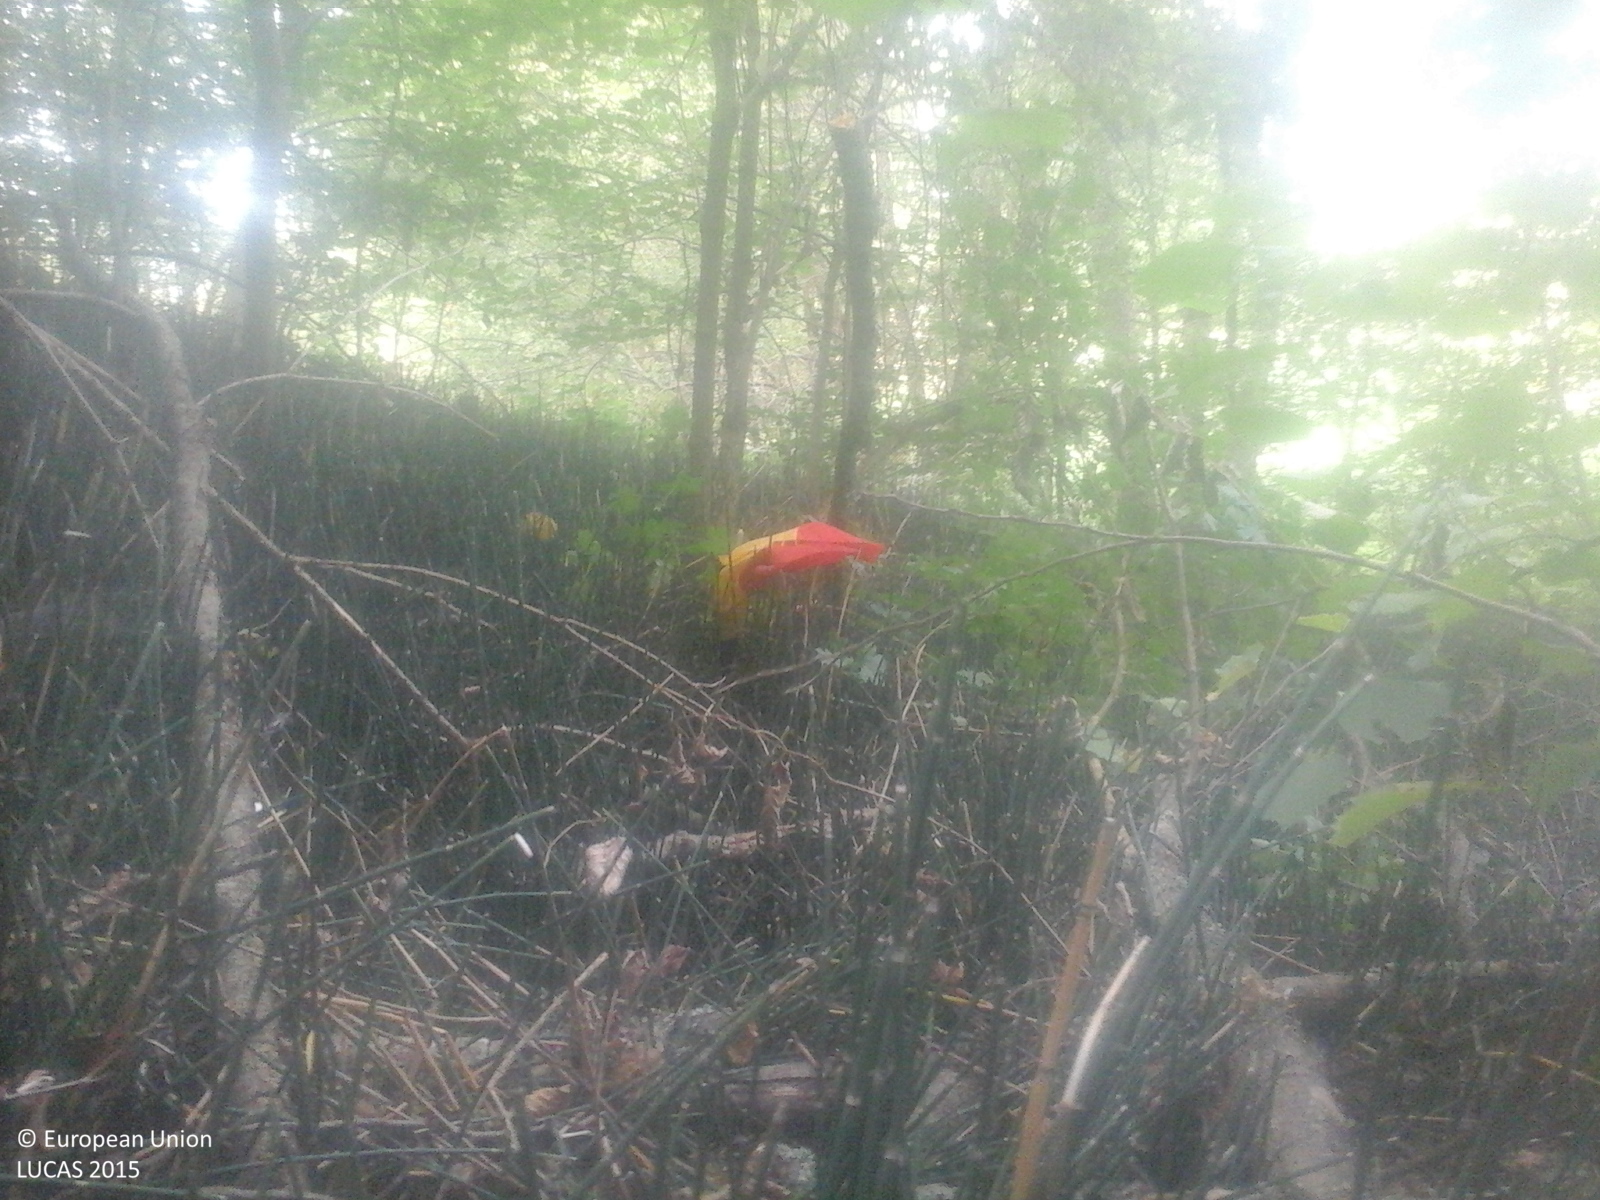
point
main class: Woodland
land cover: Broadleaved woodland
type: beech forest
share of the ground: > 75 %
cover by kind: broadleaved forest trees 100 %
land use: Forestry
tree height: > 5 m
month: September
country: RO
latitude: 46.0689
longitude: 22.8141
